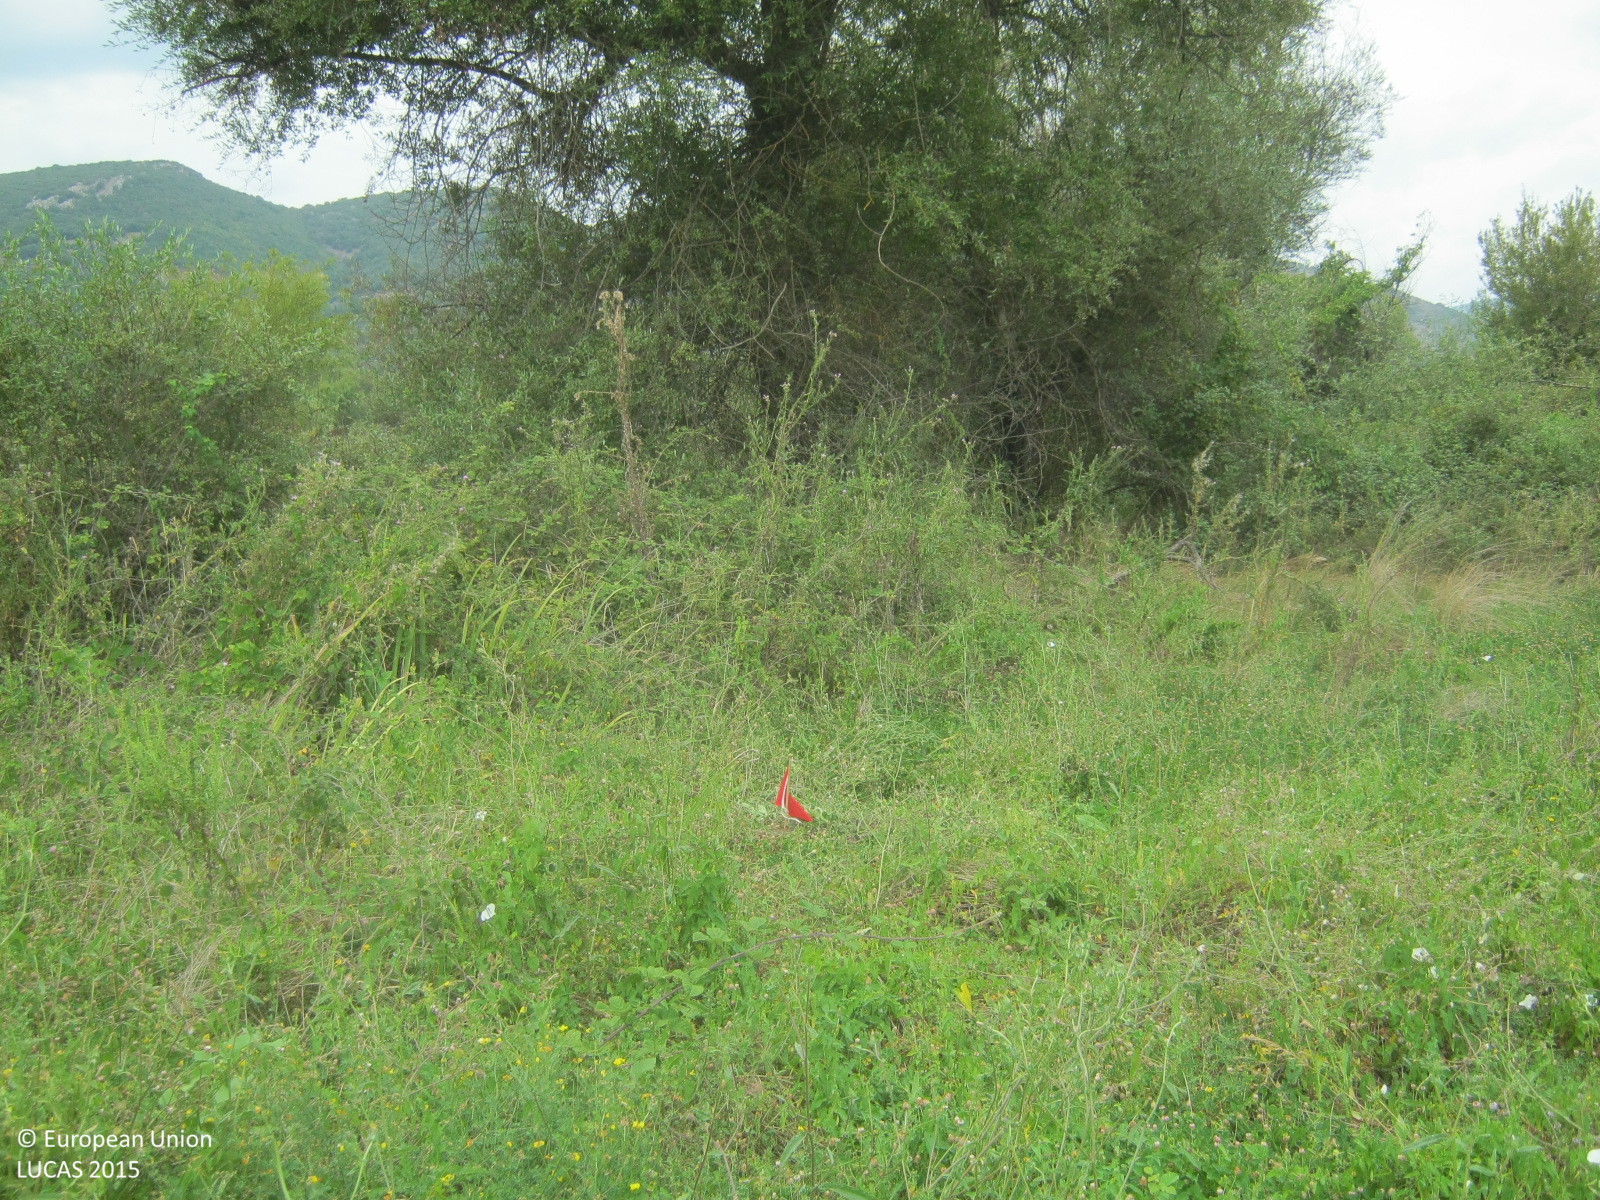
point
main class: Grassland
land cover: Grassland with sparse tree/shrub cover
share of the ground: > 75 %
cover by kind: herbaceous plants 90 %, broadleaved forest trees 5 %, shrubs 5 %
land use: Semi-natural and natural areas not in use
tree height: > 5 m
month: September
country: GR
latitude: 37.8162
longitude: 22.0848
